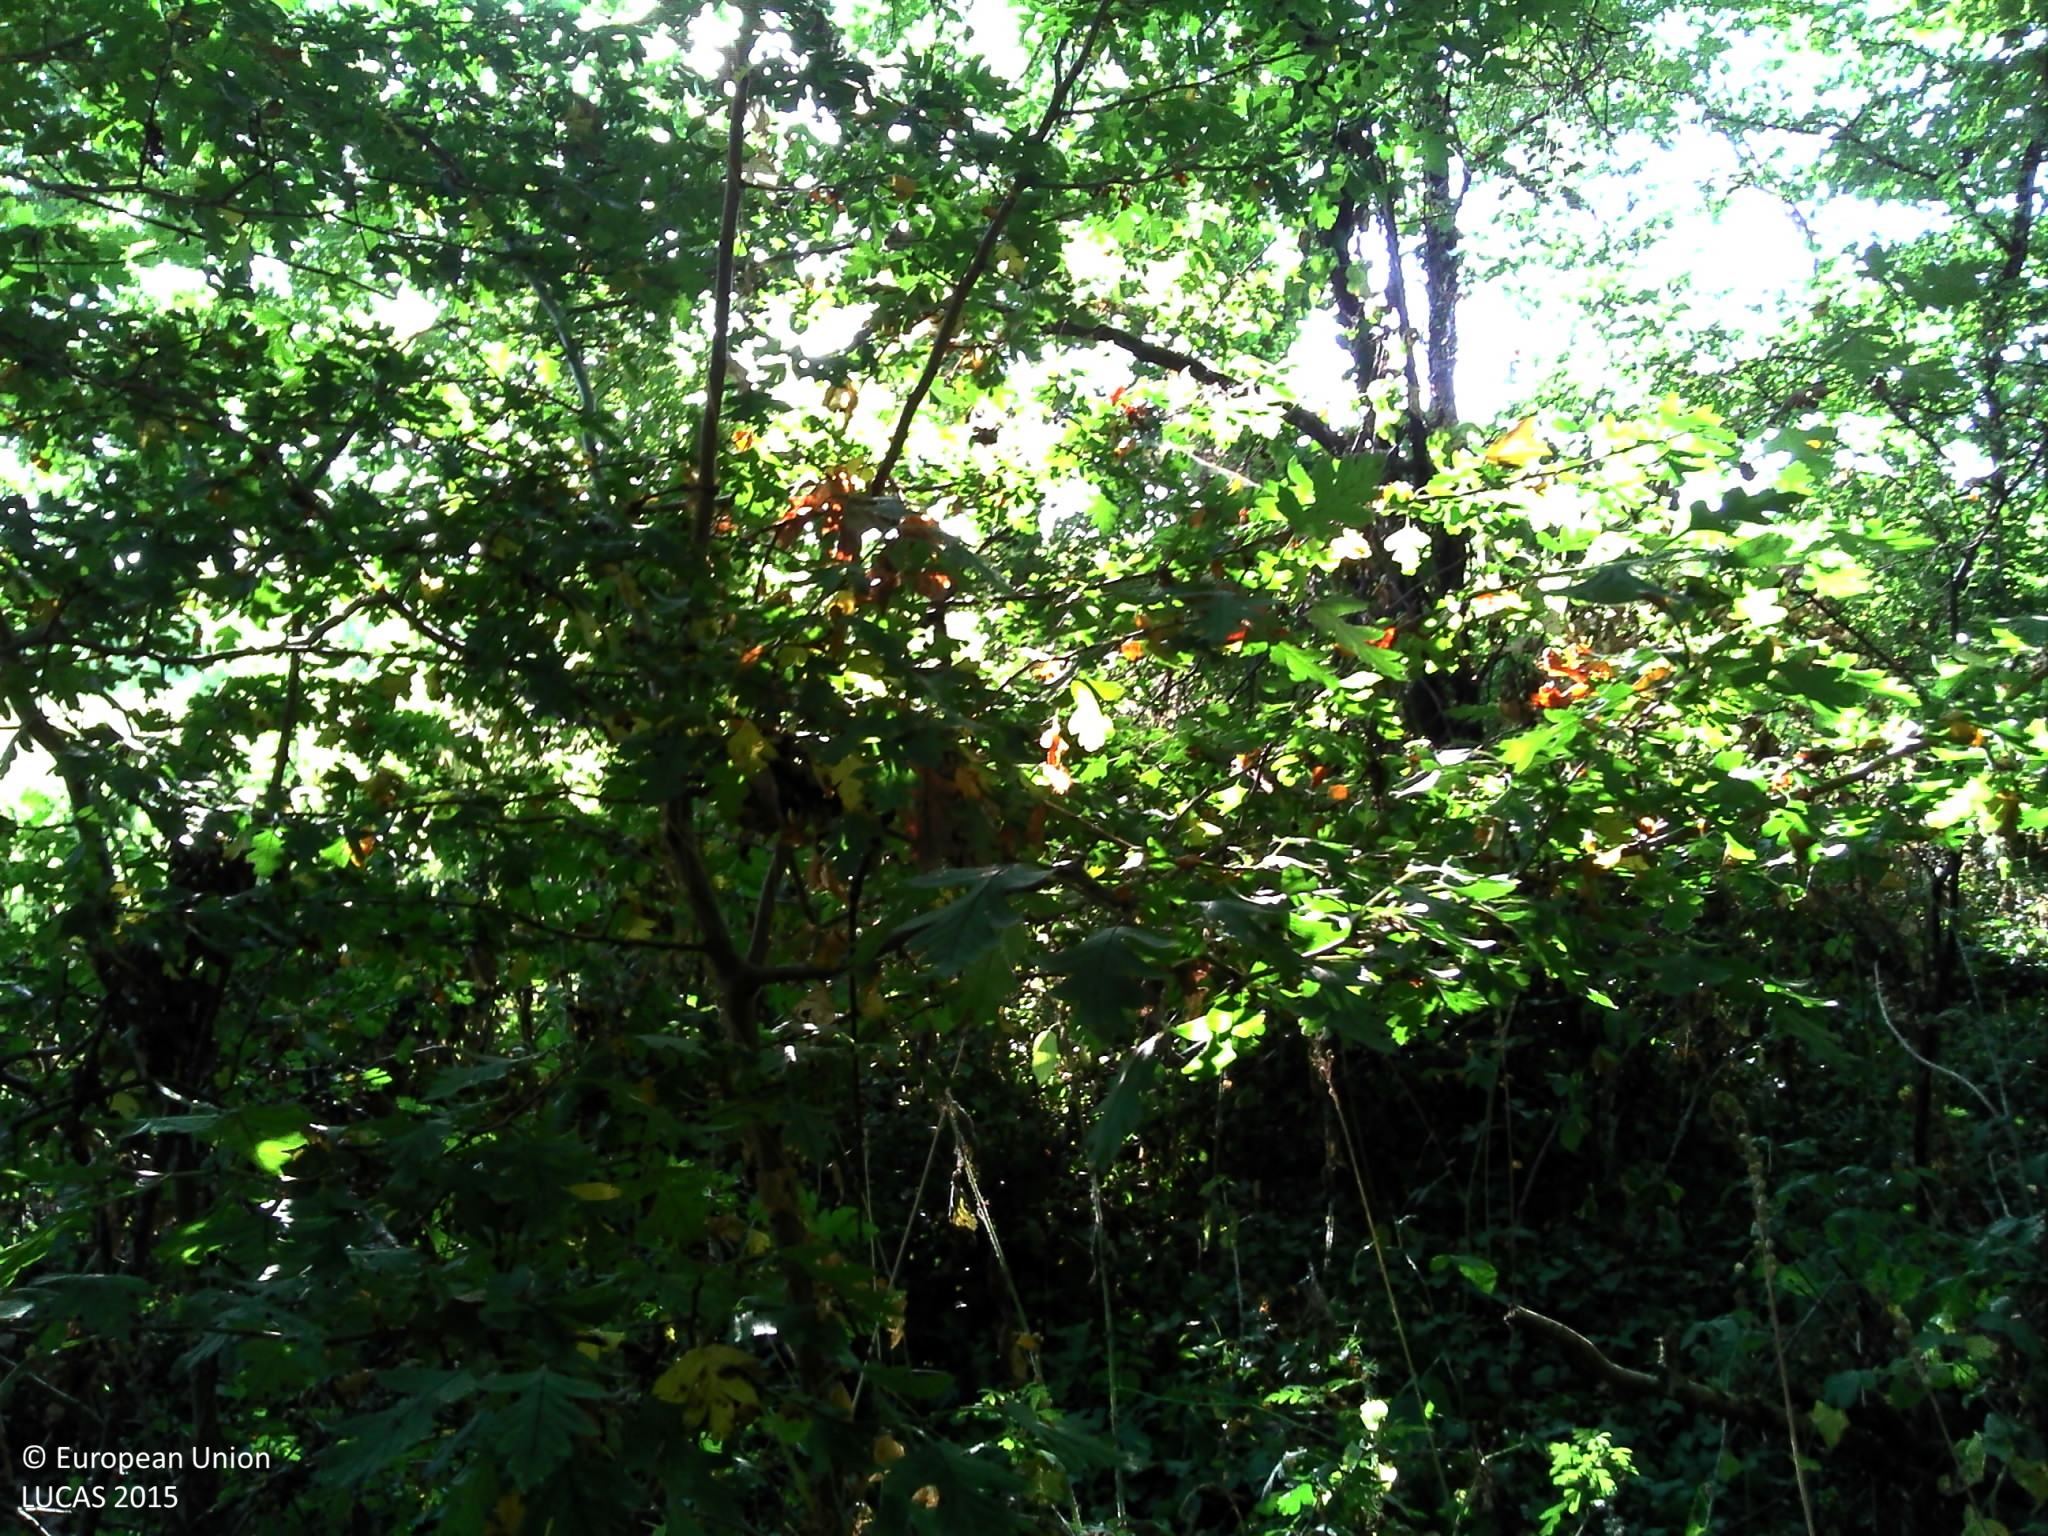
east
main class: Woodland
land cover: Broadleaved woodland
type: acidophilous oak and oak-birch forest
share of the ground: > 75 %
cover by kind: broadleaved forest trees 80 %, herbaceous plants 10 %, shrubs 5 %, lichens and mosses 5 %
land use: Forestry
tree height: > 5 m
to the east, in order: Broadleaved woodland; Grassland without tree/shrub cover; Sunflower
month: July
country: FR
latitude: 44.7202
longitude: 0.5863
